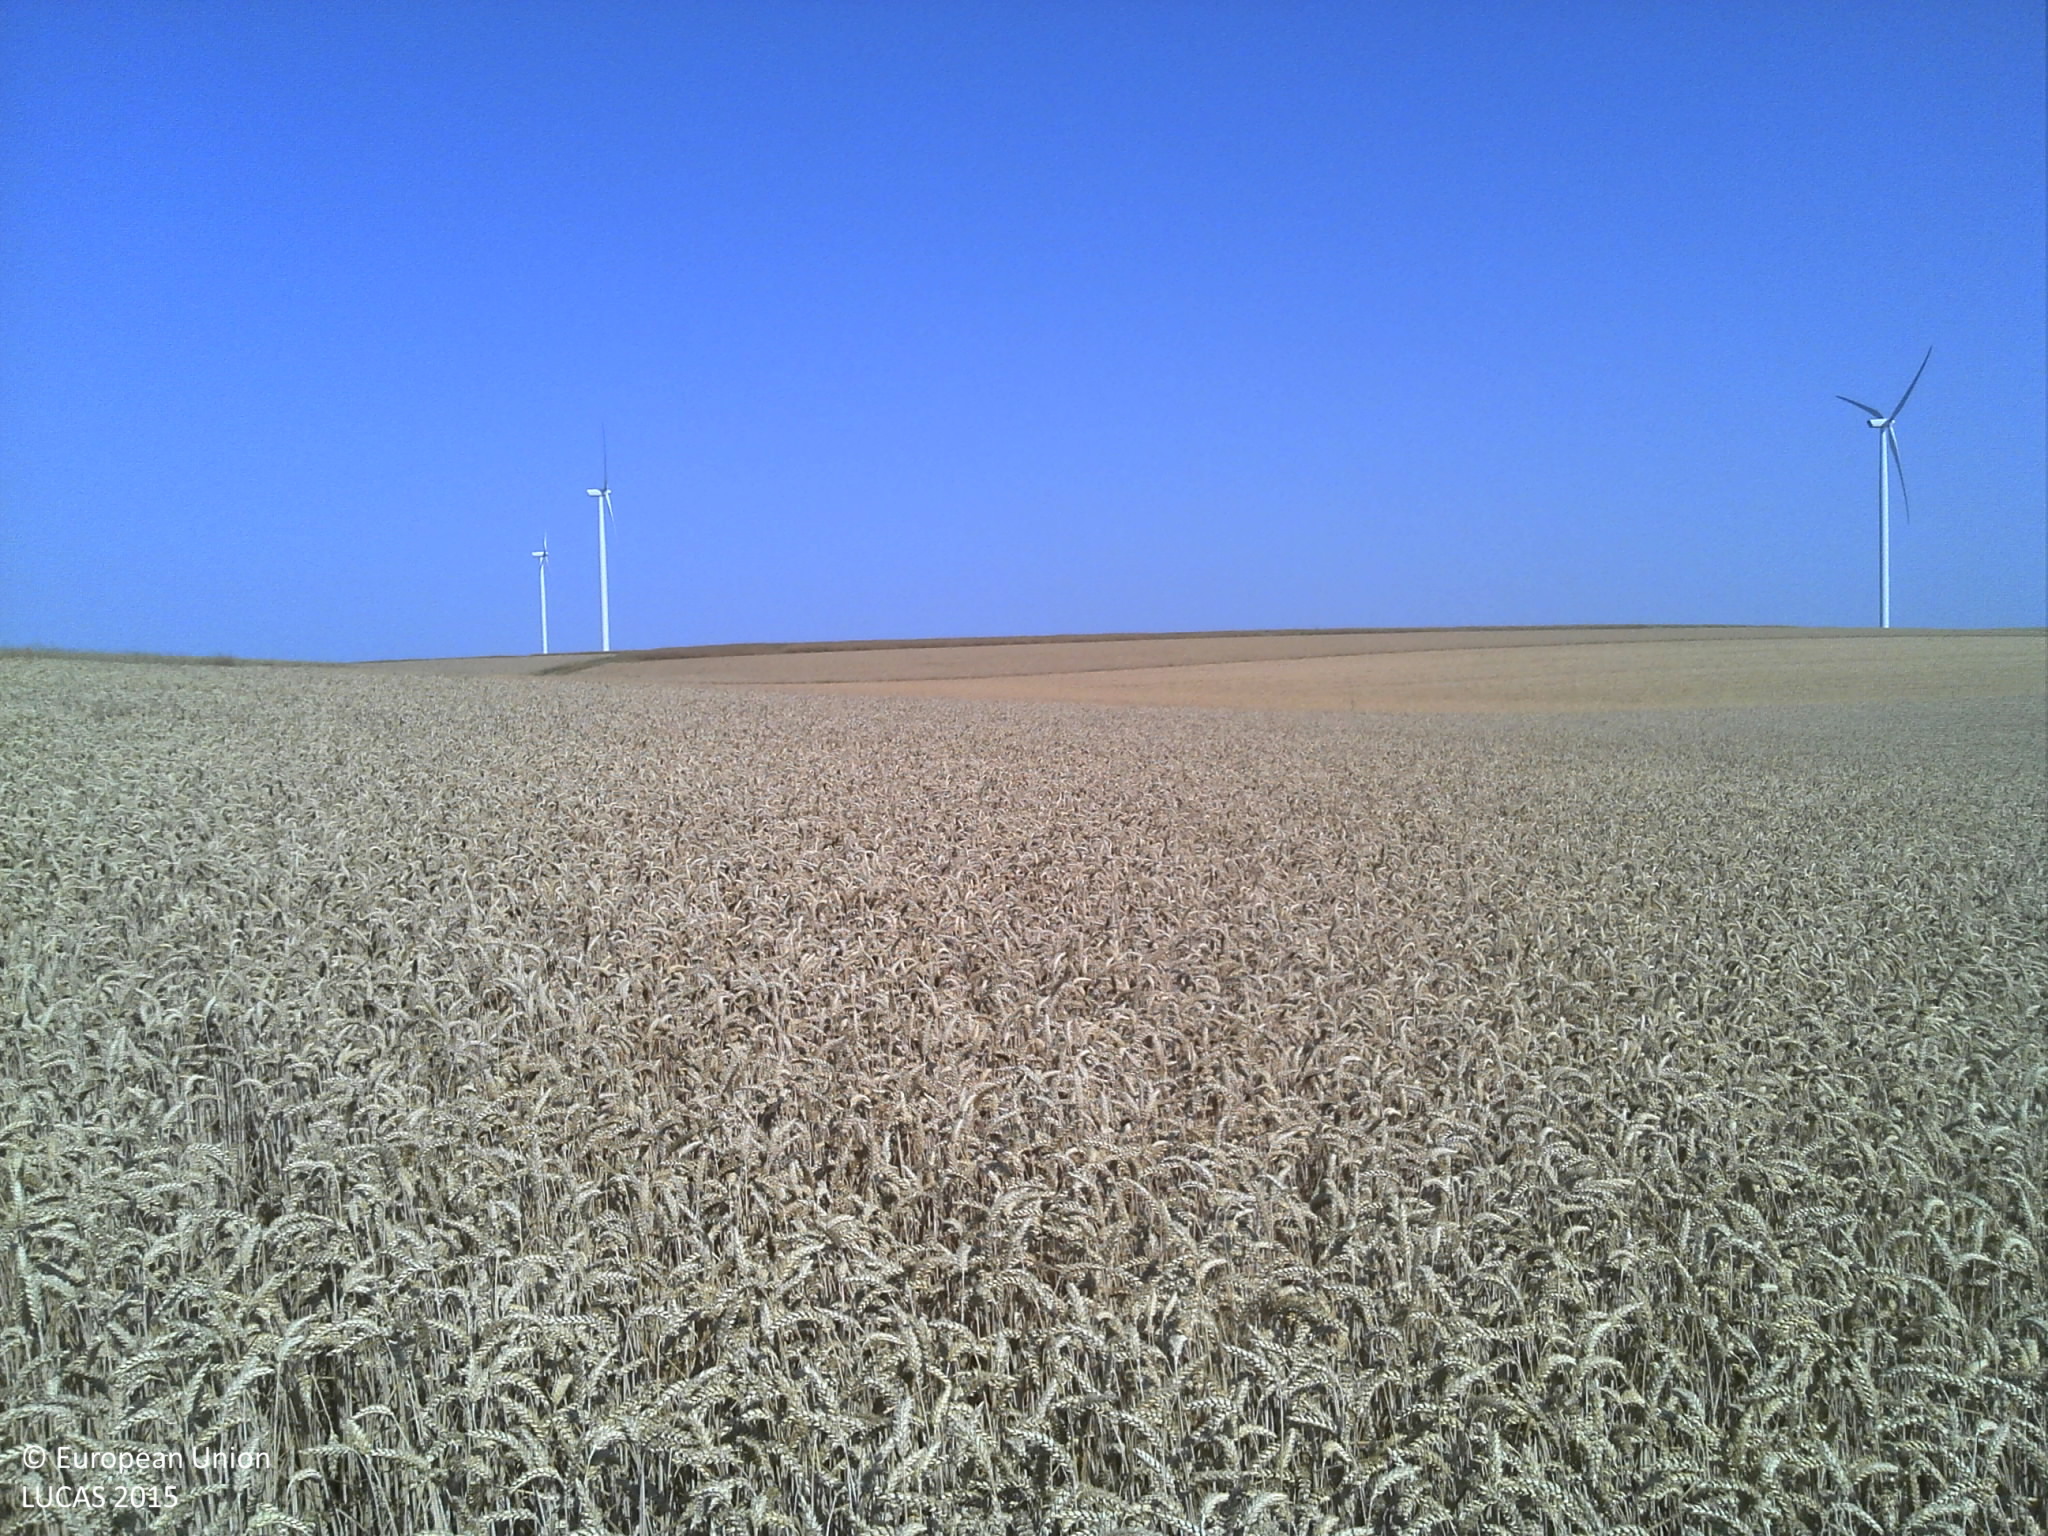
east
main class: Cropland
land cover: Common wheat
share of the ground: > 75 %
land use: Agriculture (excluding fallow land and kitchen gardens)
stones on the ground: < 10 %
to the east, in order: Common wheat; Barley; Common wheat; Tracks; Rape and turnip rape
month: July
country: FR
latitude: 49.4632
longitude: 4.2696
